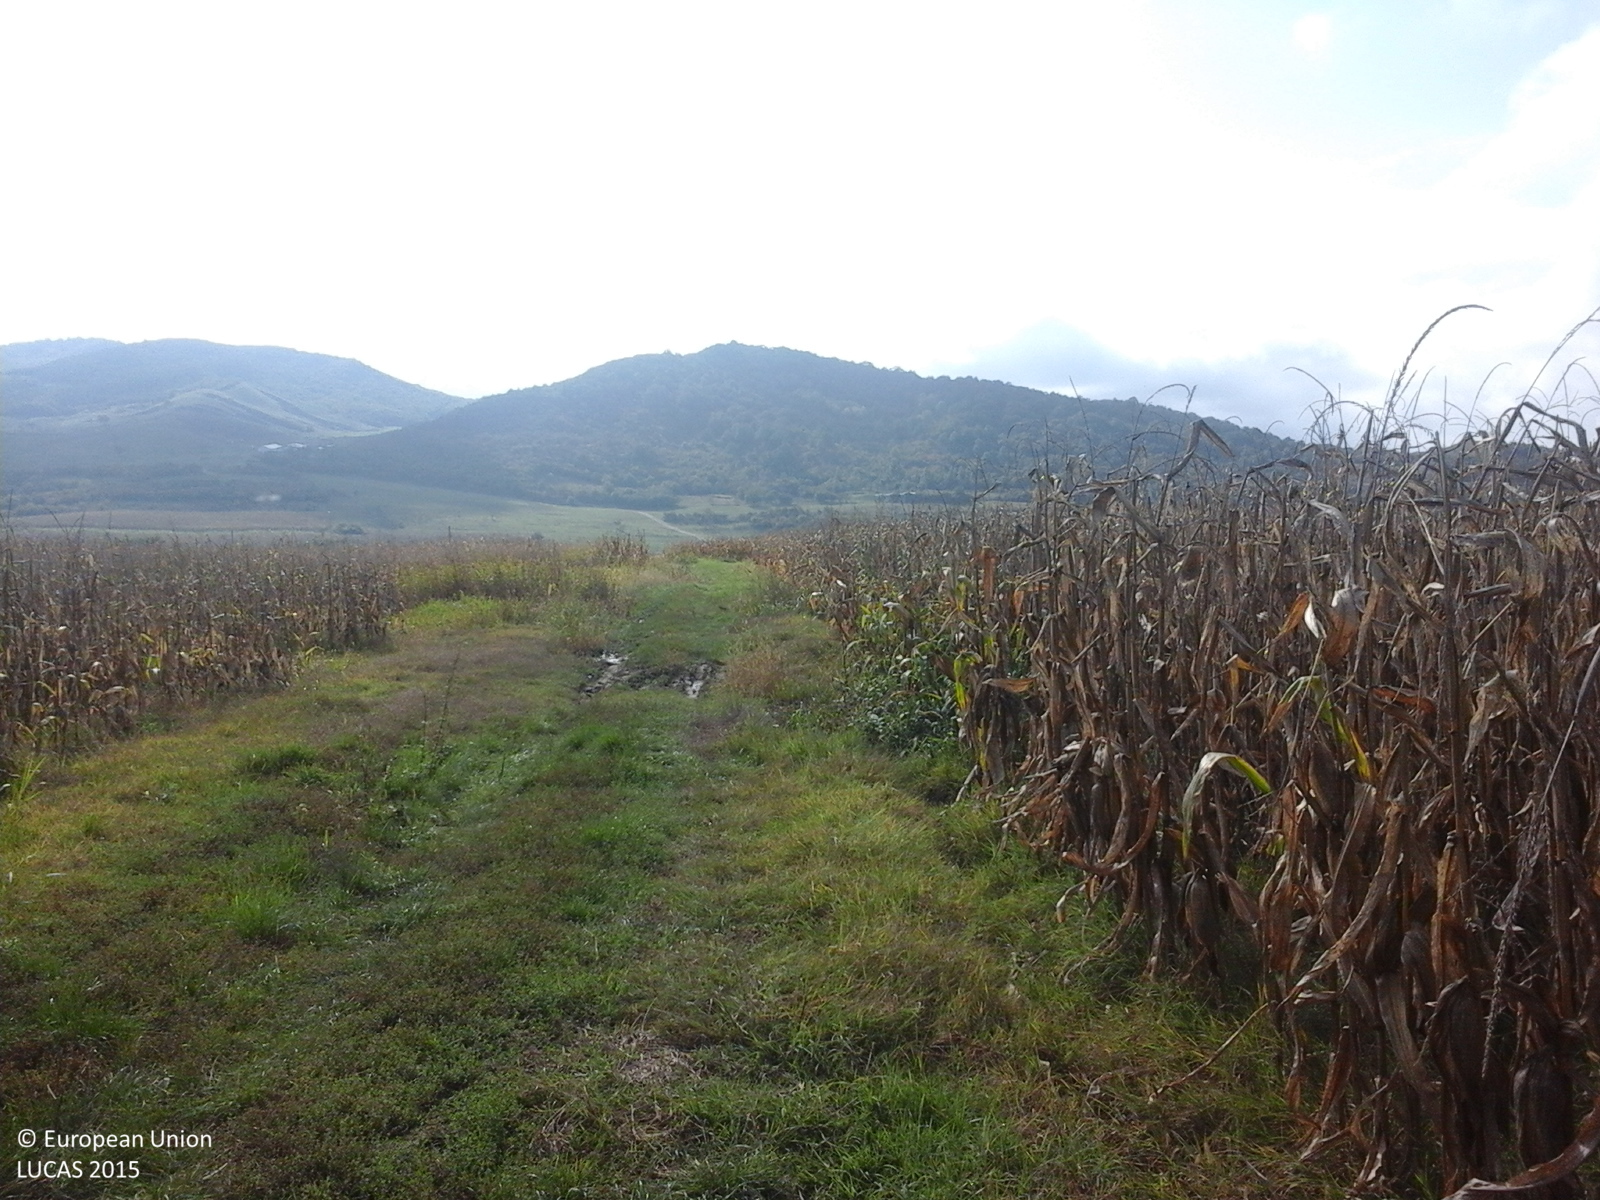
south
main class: Cropland
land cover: Maize
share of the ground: > 75 %
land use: Agriculture (excluding fallow land and kitchen gardens)
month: October
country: RO
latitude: 46.4170
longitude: 23.9577
